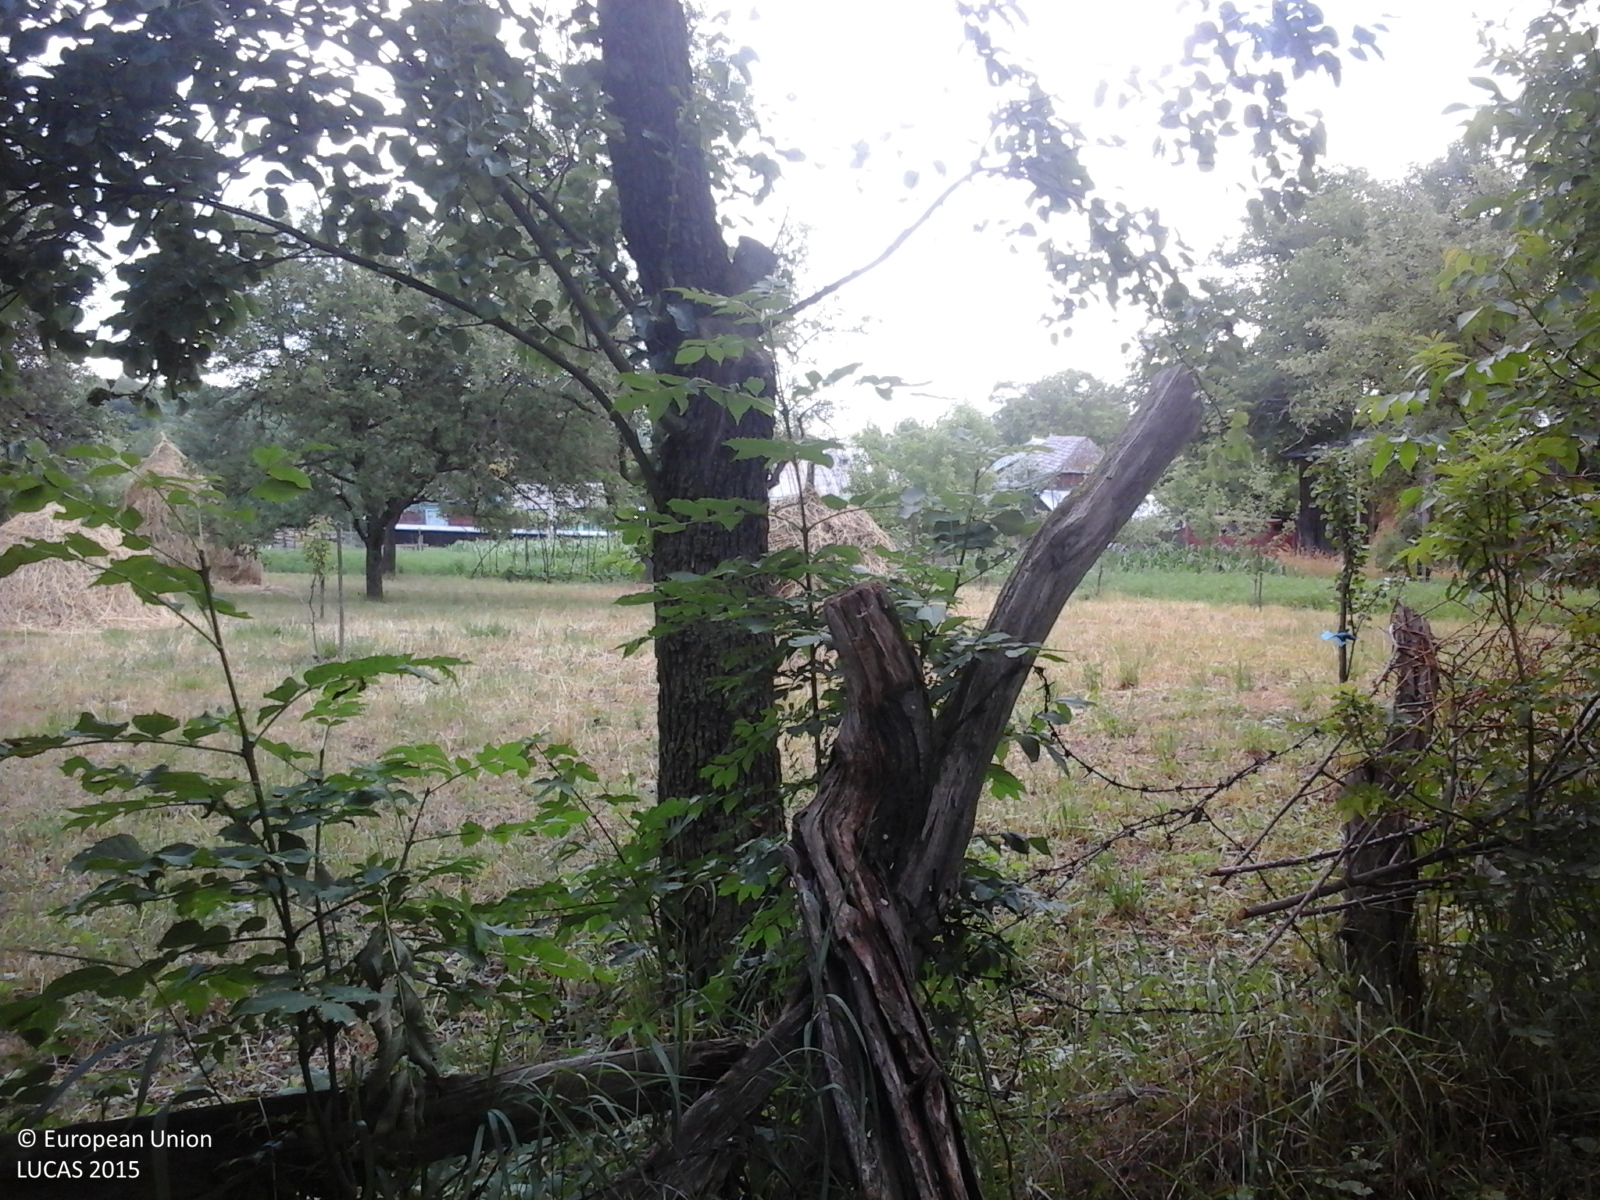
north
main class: Woodland
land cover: Broadleaved woodland
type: exotic forest
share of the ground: > 75 %
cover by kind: broadleaved forest trees 100 %
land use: Forestry
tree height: > 5 m
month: June
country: RO
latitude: 47.1052
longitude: 26.3288
